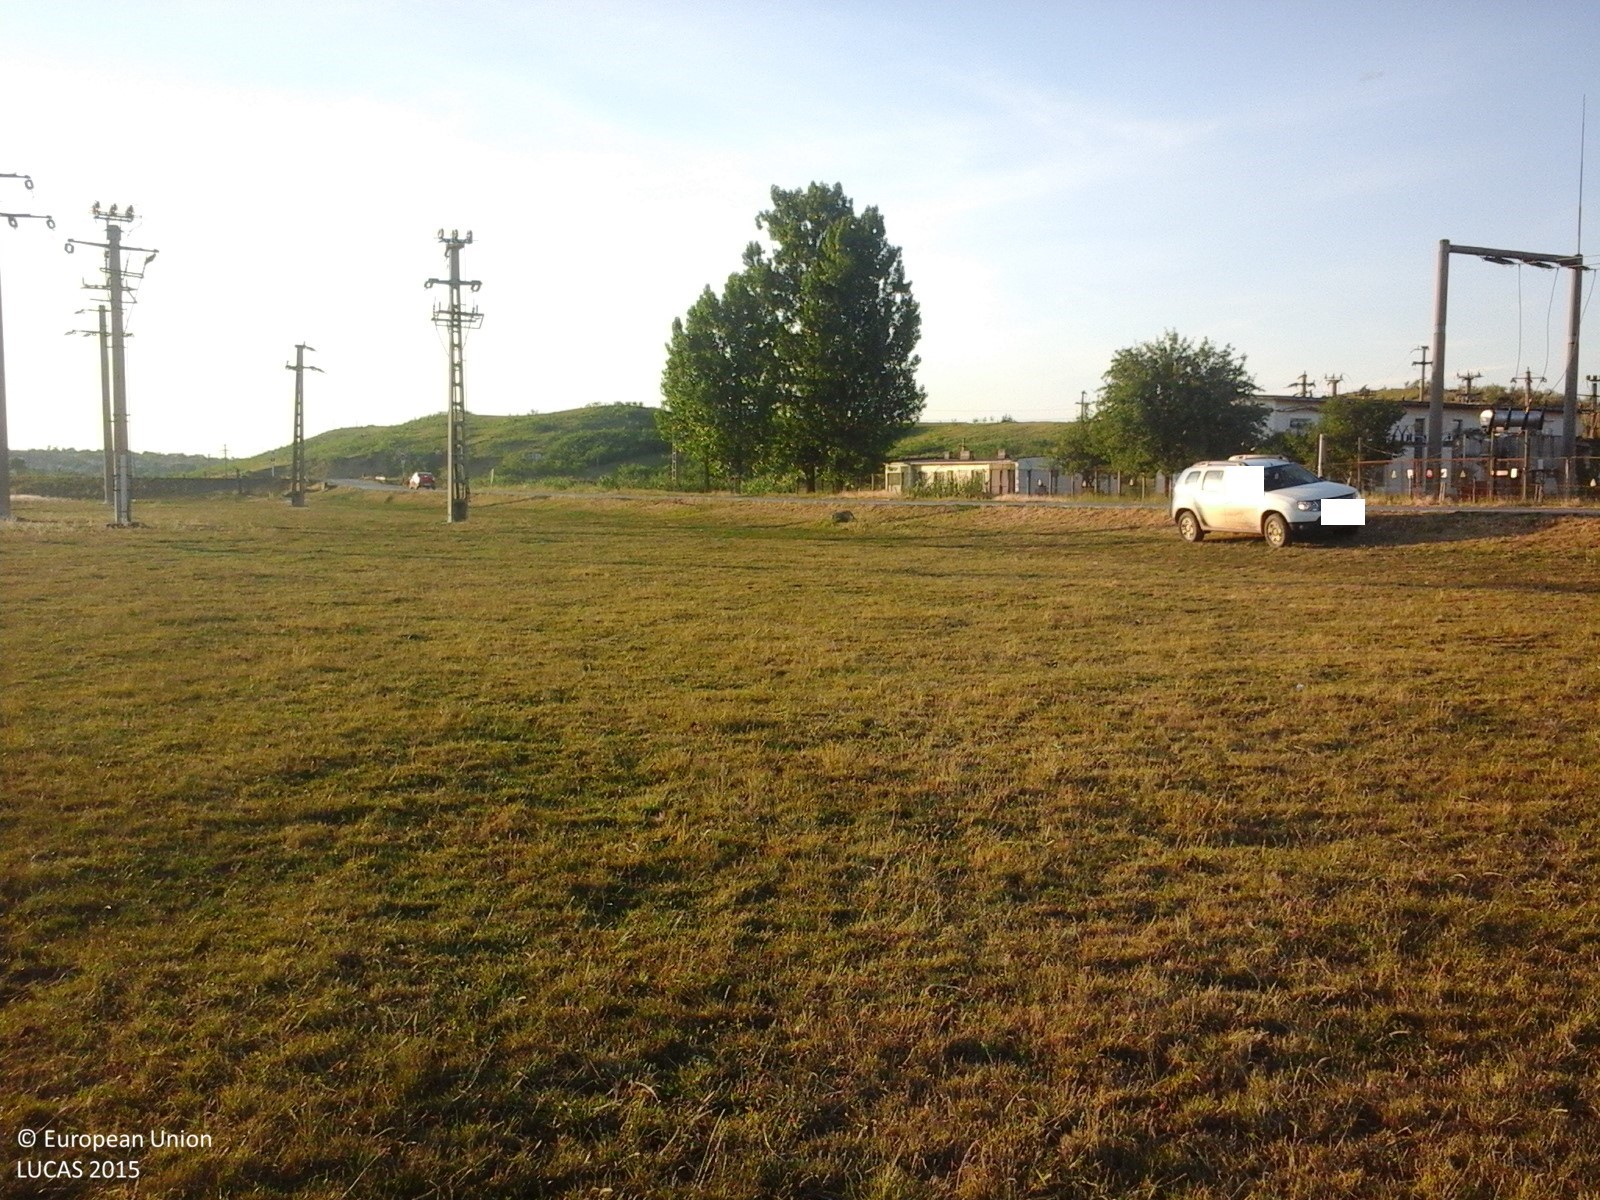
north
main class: Grassland
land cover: Grassland without tree/shrub cover
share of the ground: > 75 %
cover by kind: herbaceous plants 100 %
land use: Agriculture (excluding fallow land and kitchen gardens)
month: June
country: RO
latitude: 47.2974
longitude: 27.0982
